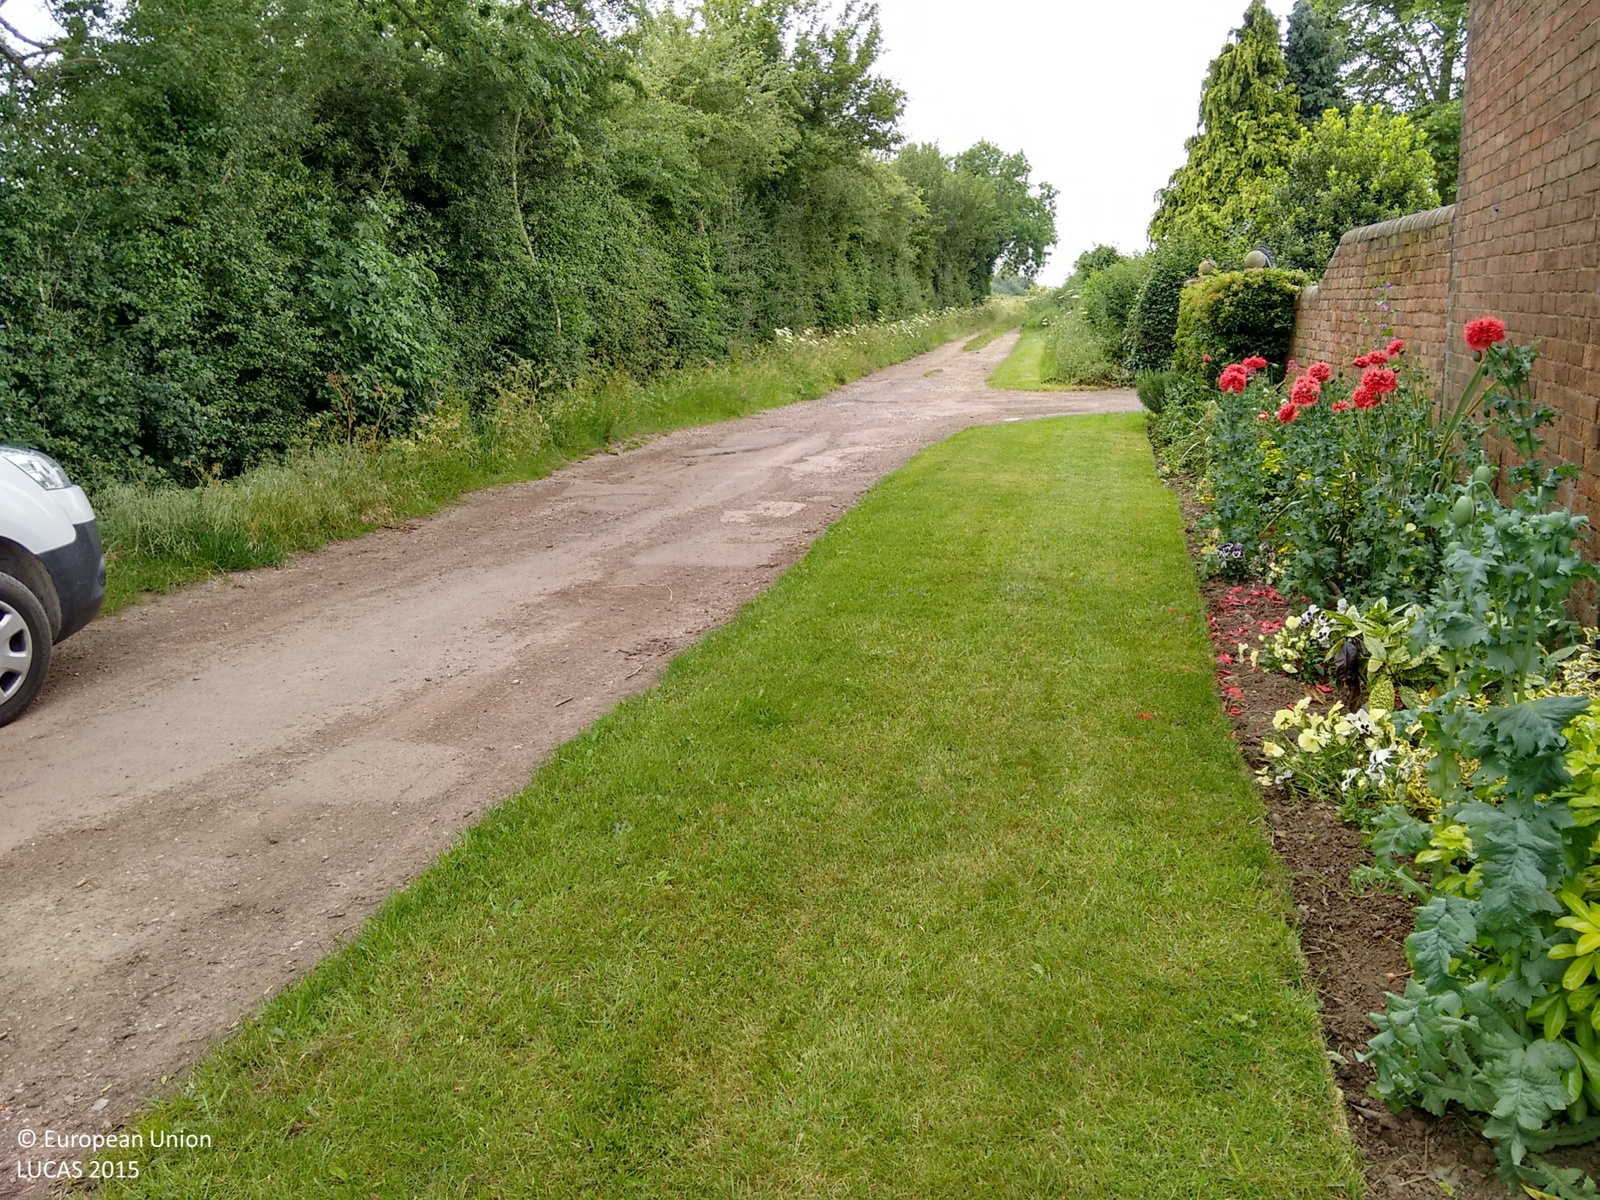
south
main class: Grassland
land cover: Grassland without tree/shrub cover
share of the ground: > 75 %
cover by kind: herbaceous plants 100 %
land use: Agriculture (excluding fallow land and kitchen gardens)
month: June
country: GB
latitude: 53.0110
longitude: -0.9683
